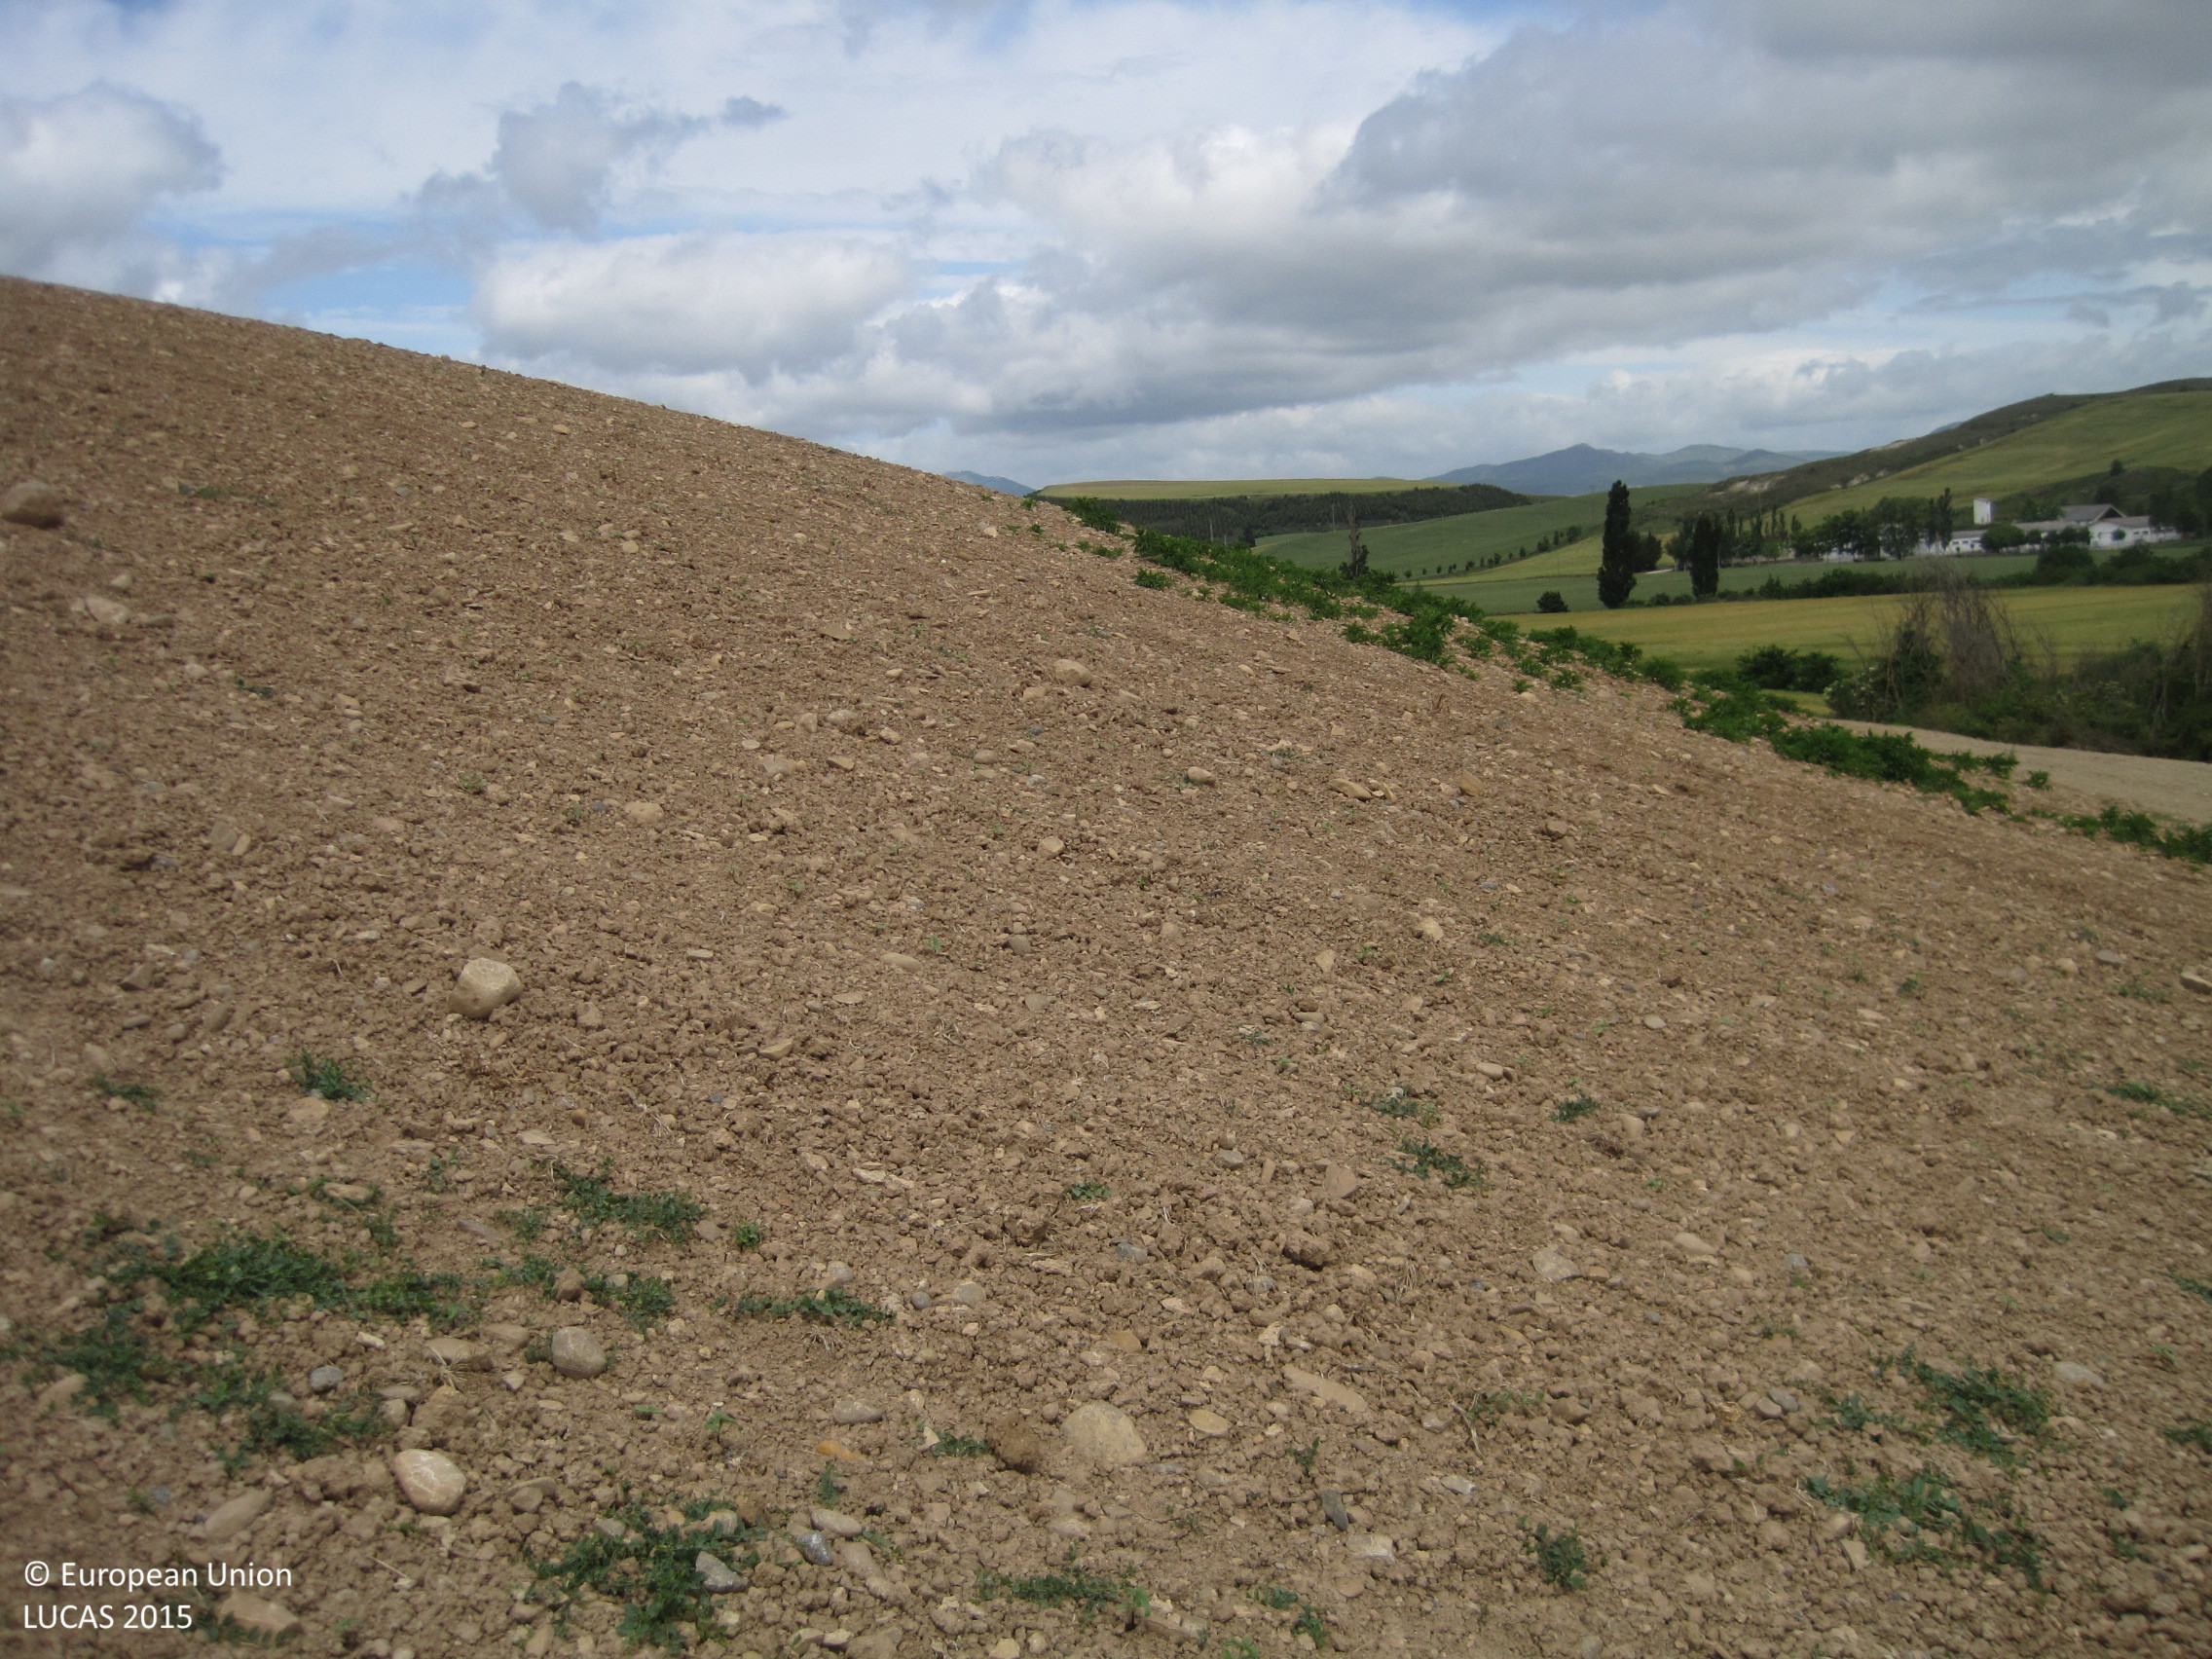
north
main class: Cropland
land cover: Sunflower
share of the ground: < 10 %
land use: Agriculture (excluding fallow land and kitchen gardens)
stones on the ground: < 10 %
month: May
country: ES
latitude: 42.7685
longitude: -1.7598
